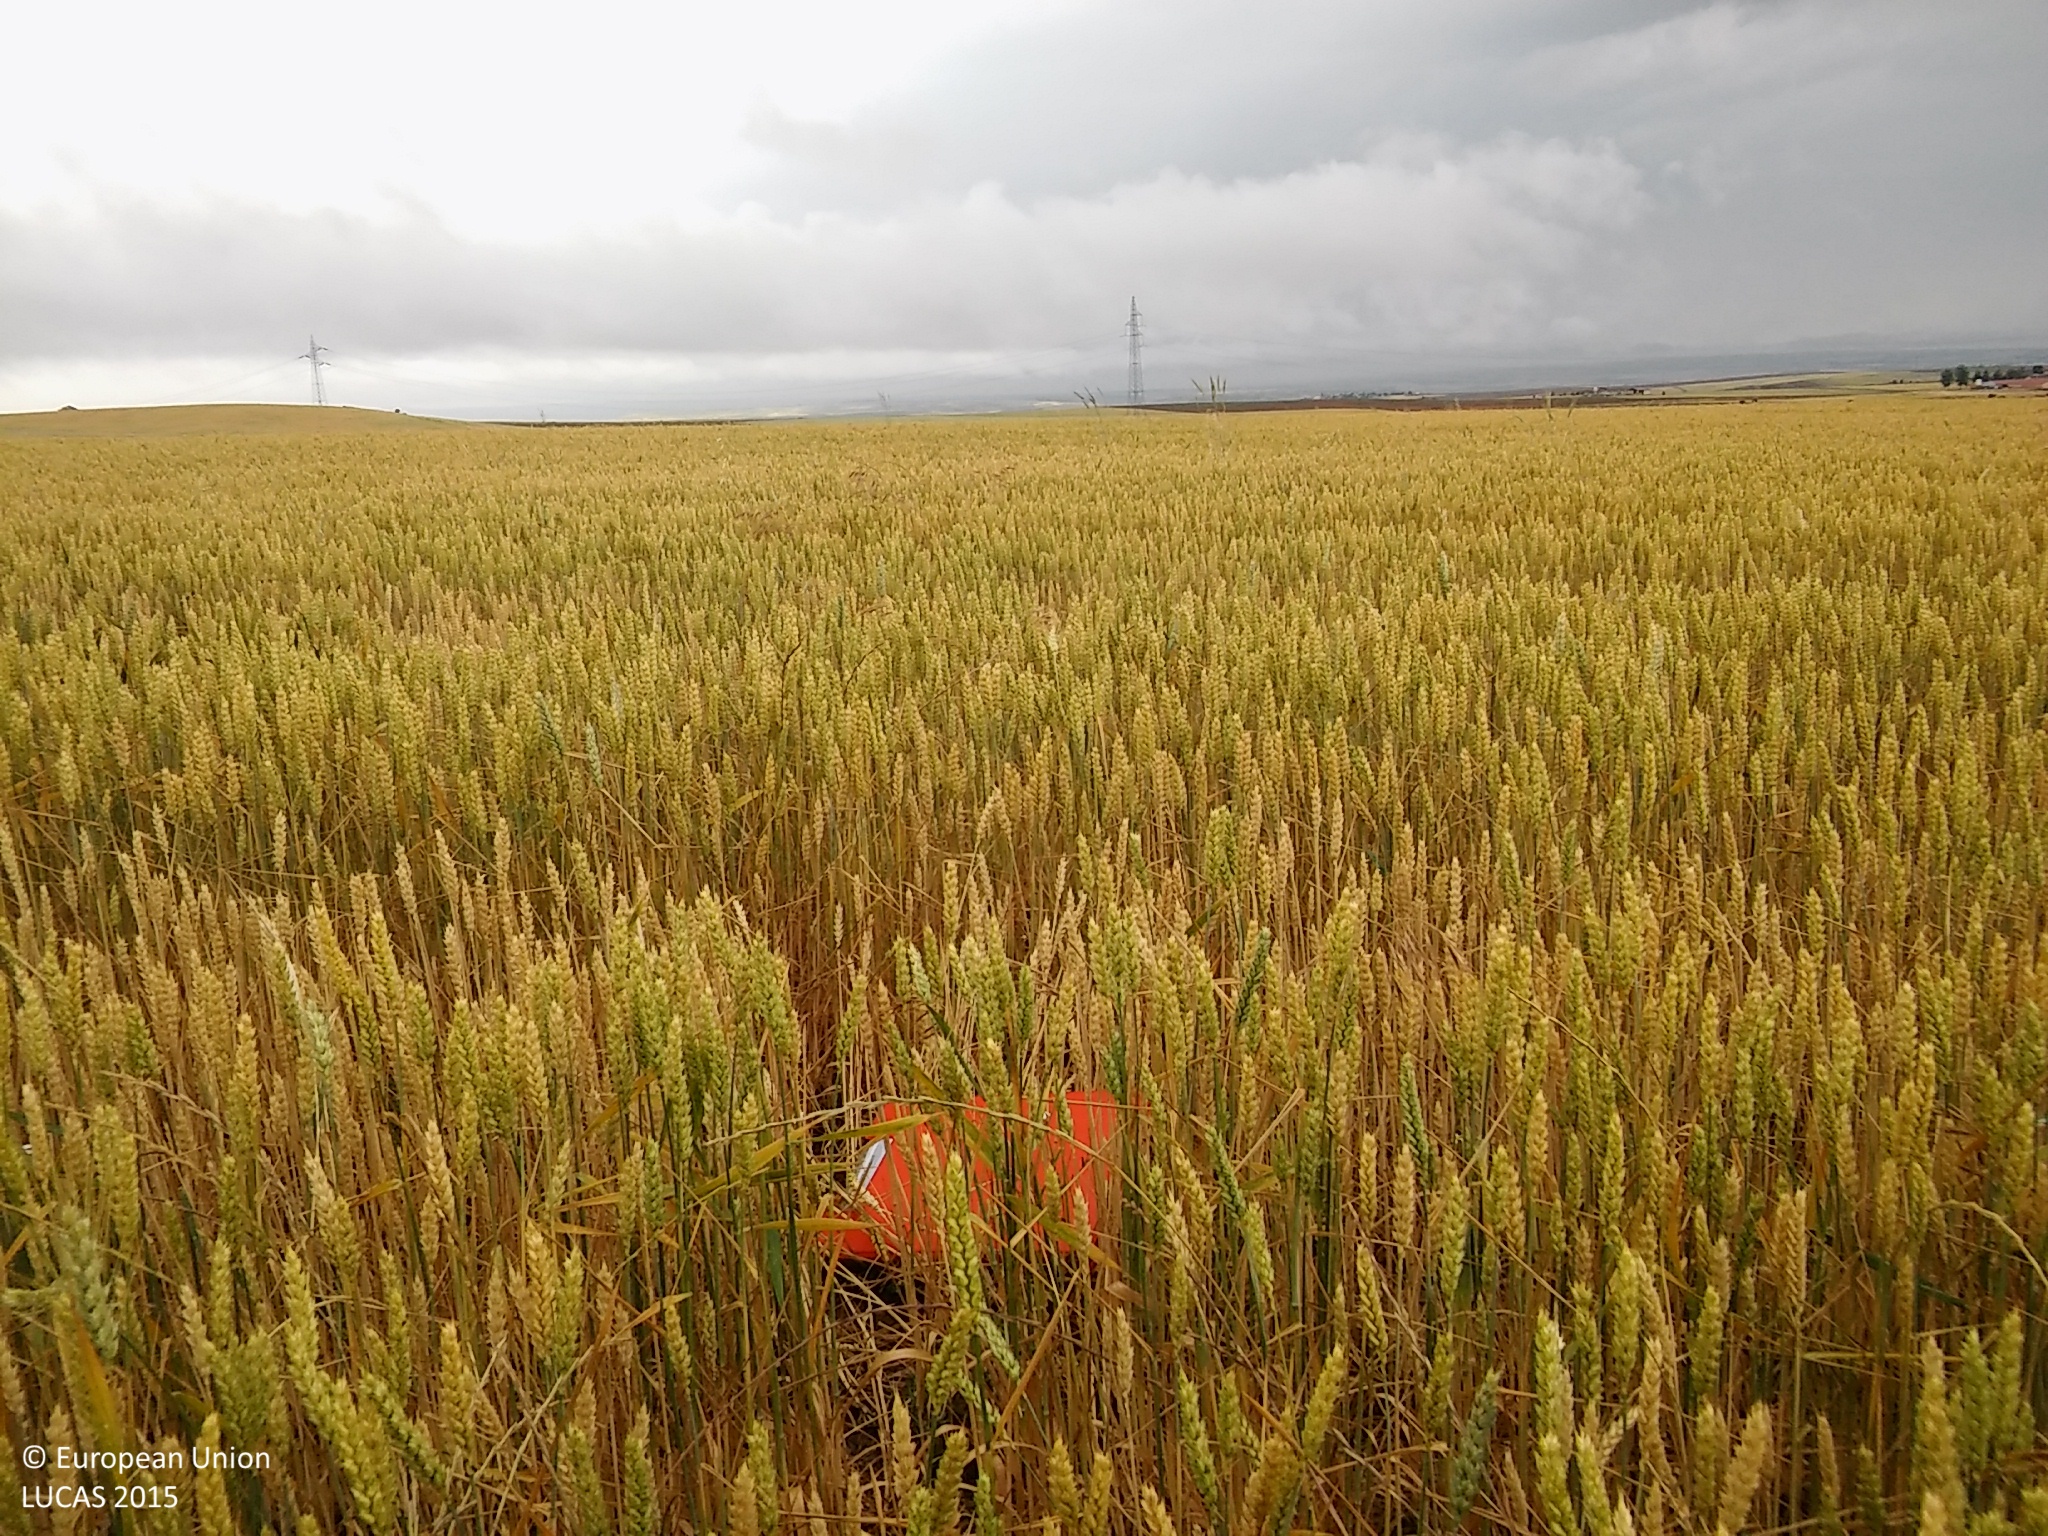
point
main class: Cropland
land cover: Common wheat
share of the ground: > 75 %
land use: Agriculture (excluding fallow land and kitchen gardens)
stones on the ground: 10 - 25 %
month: June
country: ES
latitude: 41.2233
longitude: -3.7062
